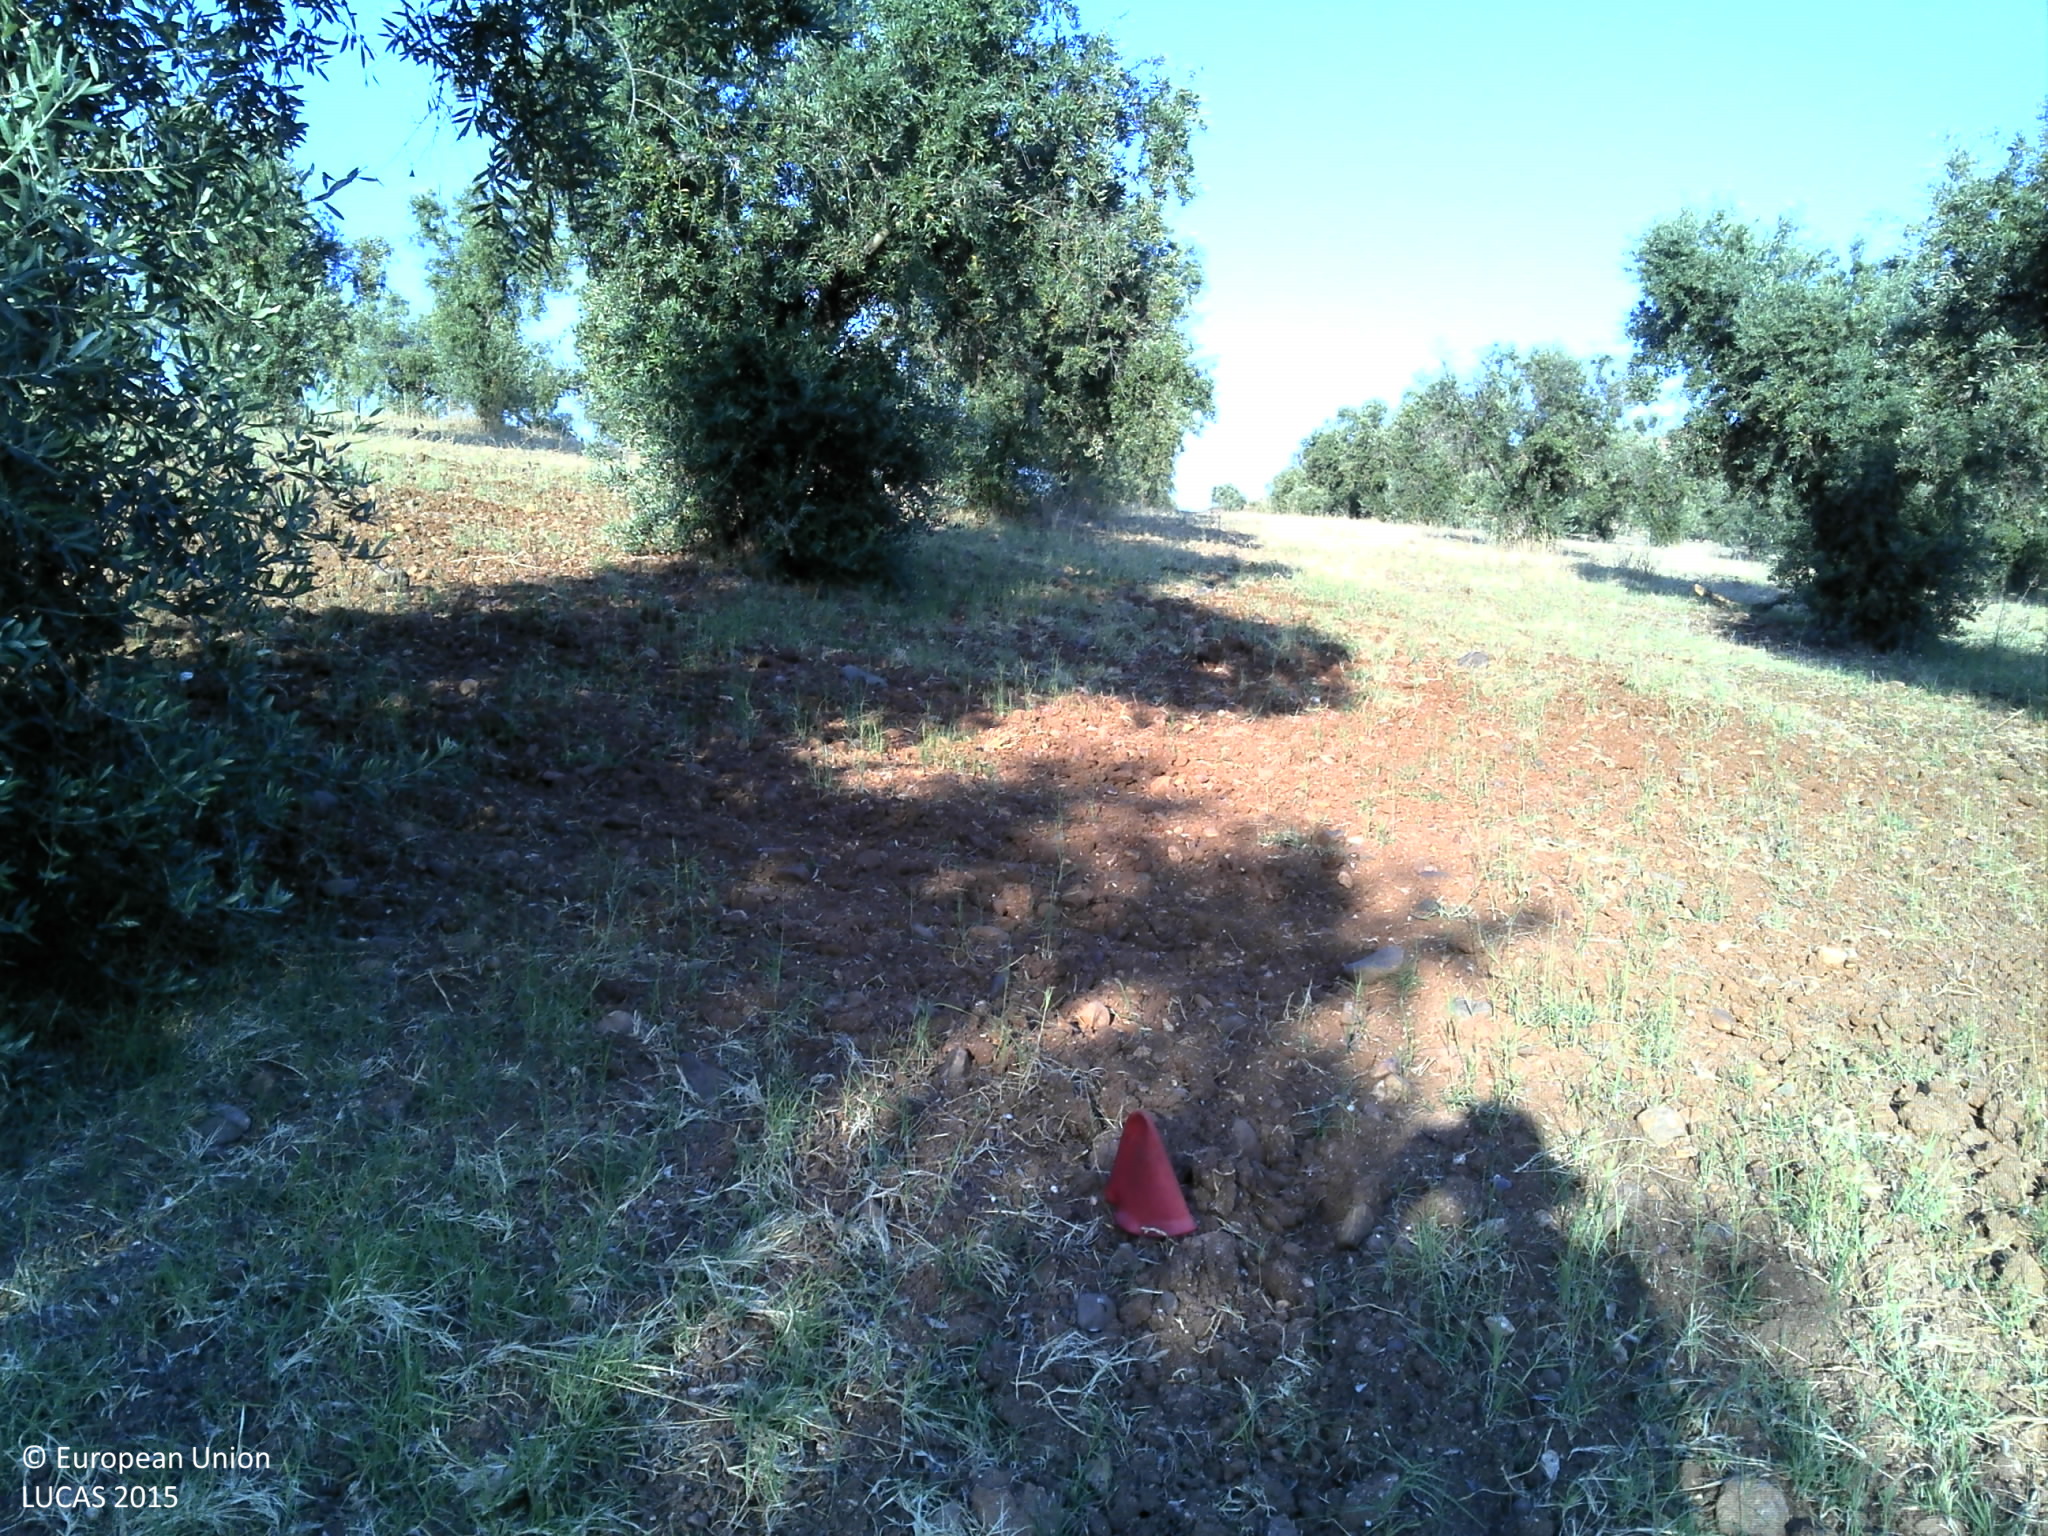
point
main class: Cropland
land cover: Olive groves
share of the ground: 25 - 50 %
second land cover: Grassland without tree/shrub cover
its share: 10 - 25 %
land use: Agriculture (excluding fallow land and kitchen gardens)
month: June
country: PT
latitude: 38.1258
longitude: -7.6028
